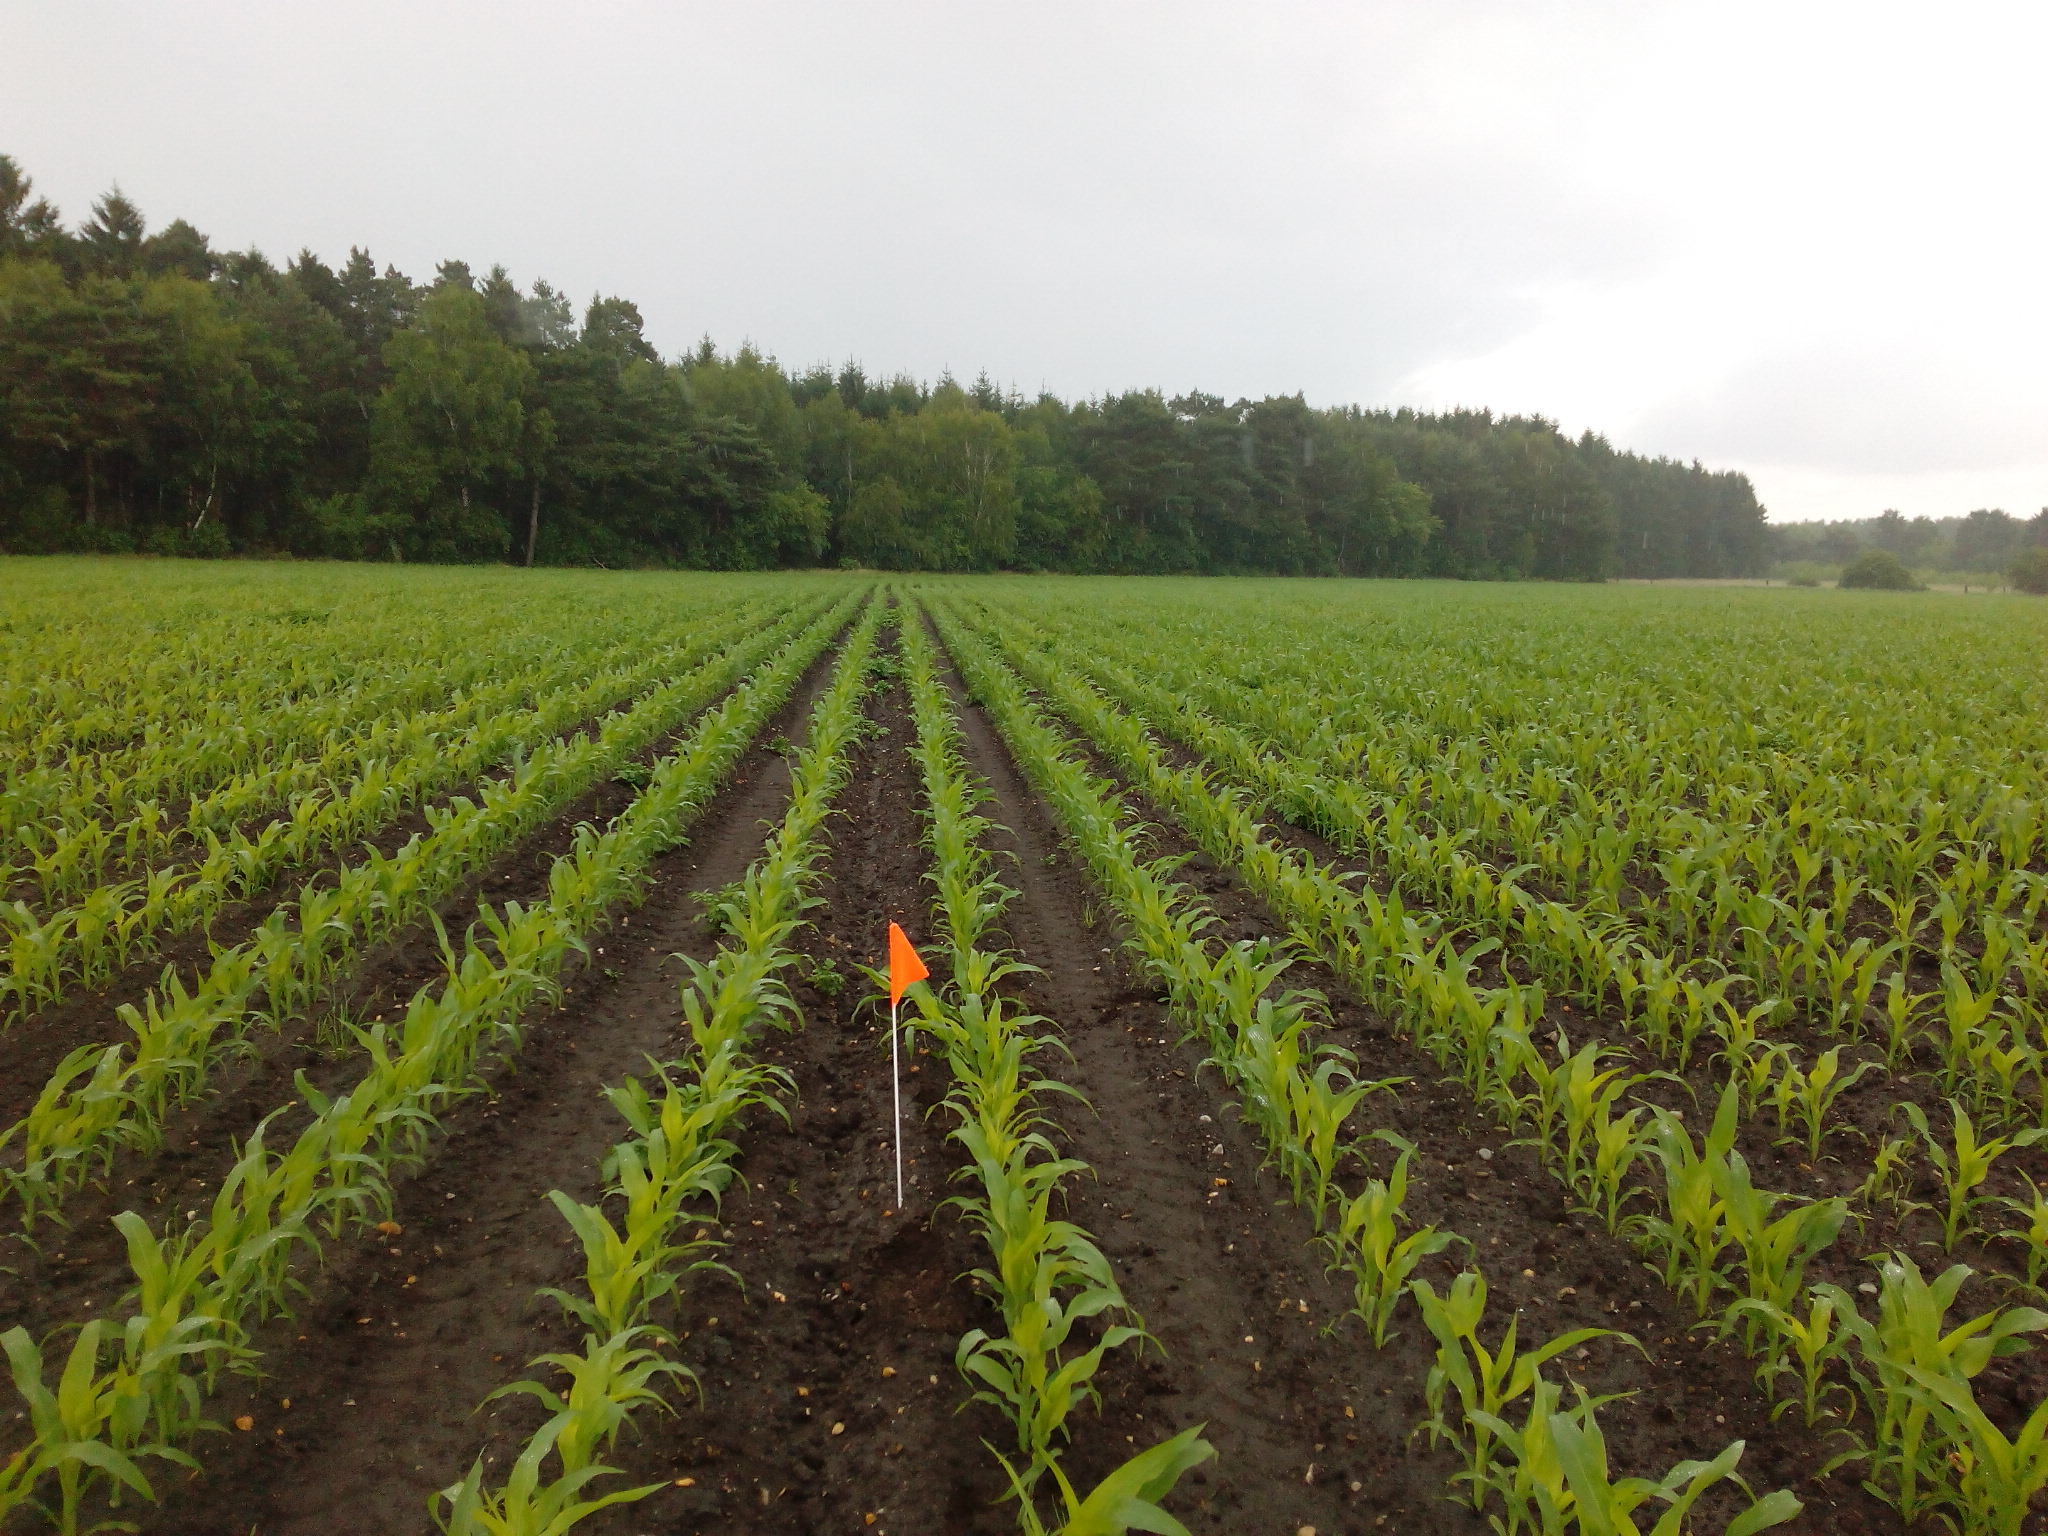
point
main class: Cropland
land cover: Maize
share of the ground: 50 - 75 %
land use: Agriculture (excluding fallow land and kitchen gardens)
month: June
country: DE
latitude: 52.8987
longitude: 9.9257
